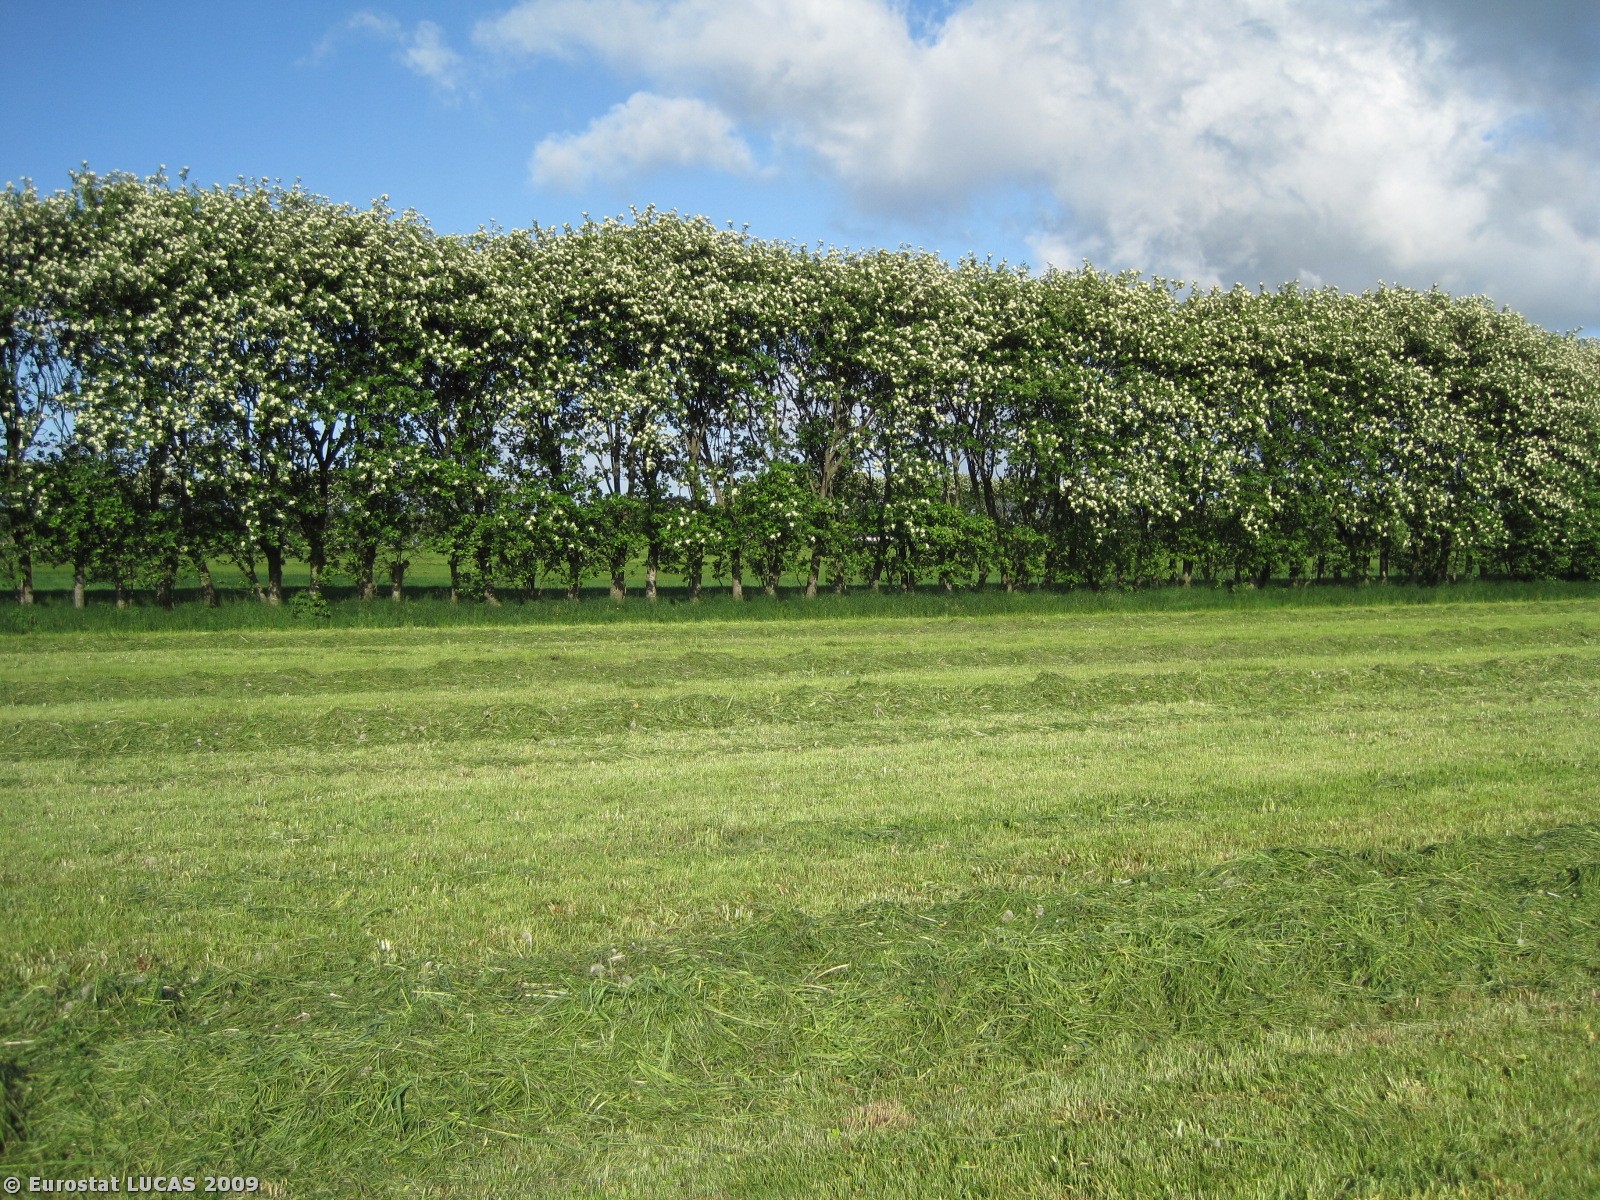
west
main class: Grassland
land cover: Grassland without tree/shrub cover
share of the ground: > 75 %
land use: Agriculture (excluding fallow land and kitchen gardens)
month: May
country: DK
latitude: 56.5111
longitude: 9.7566
